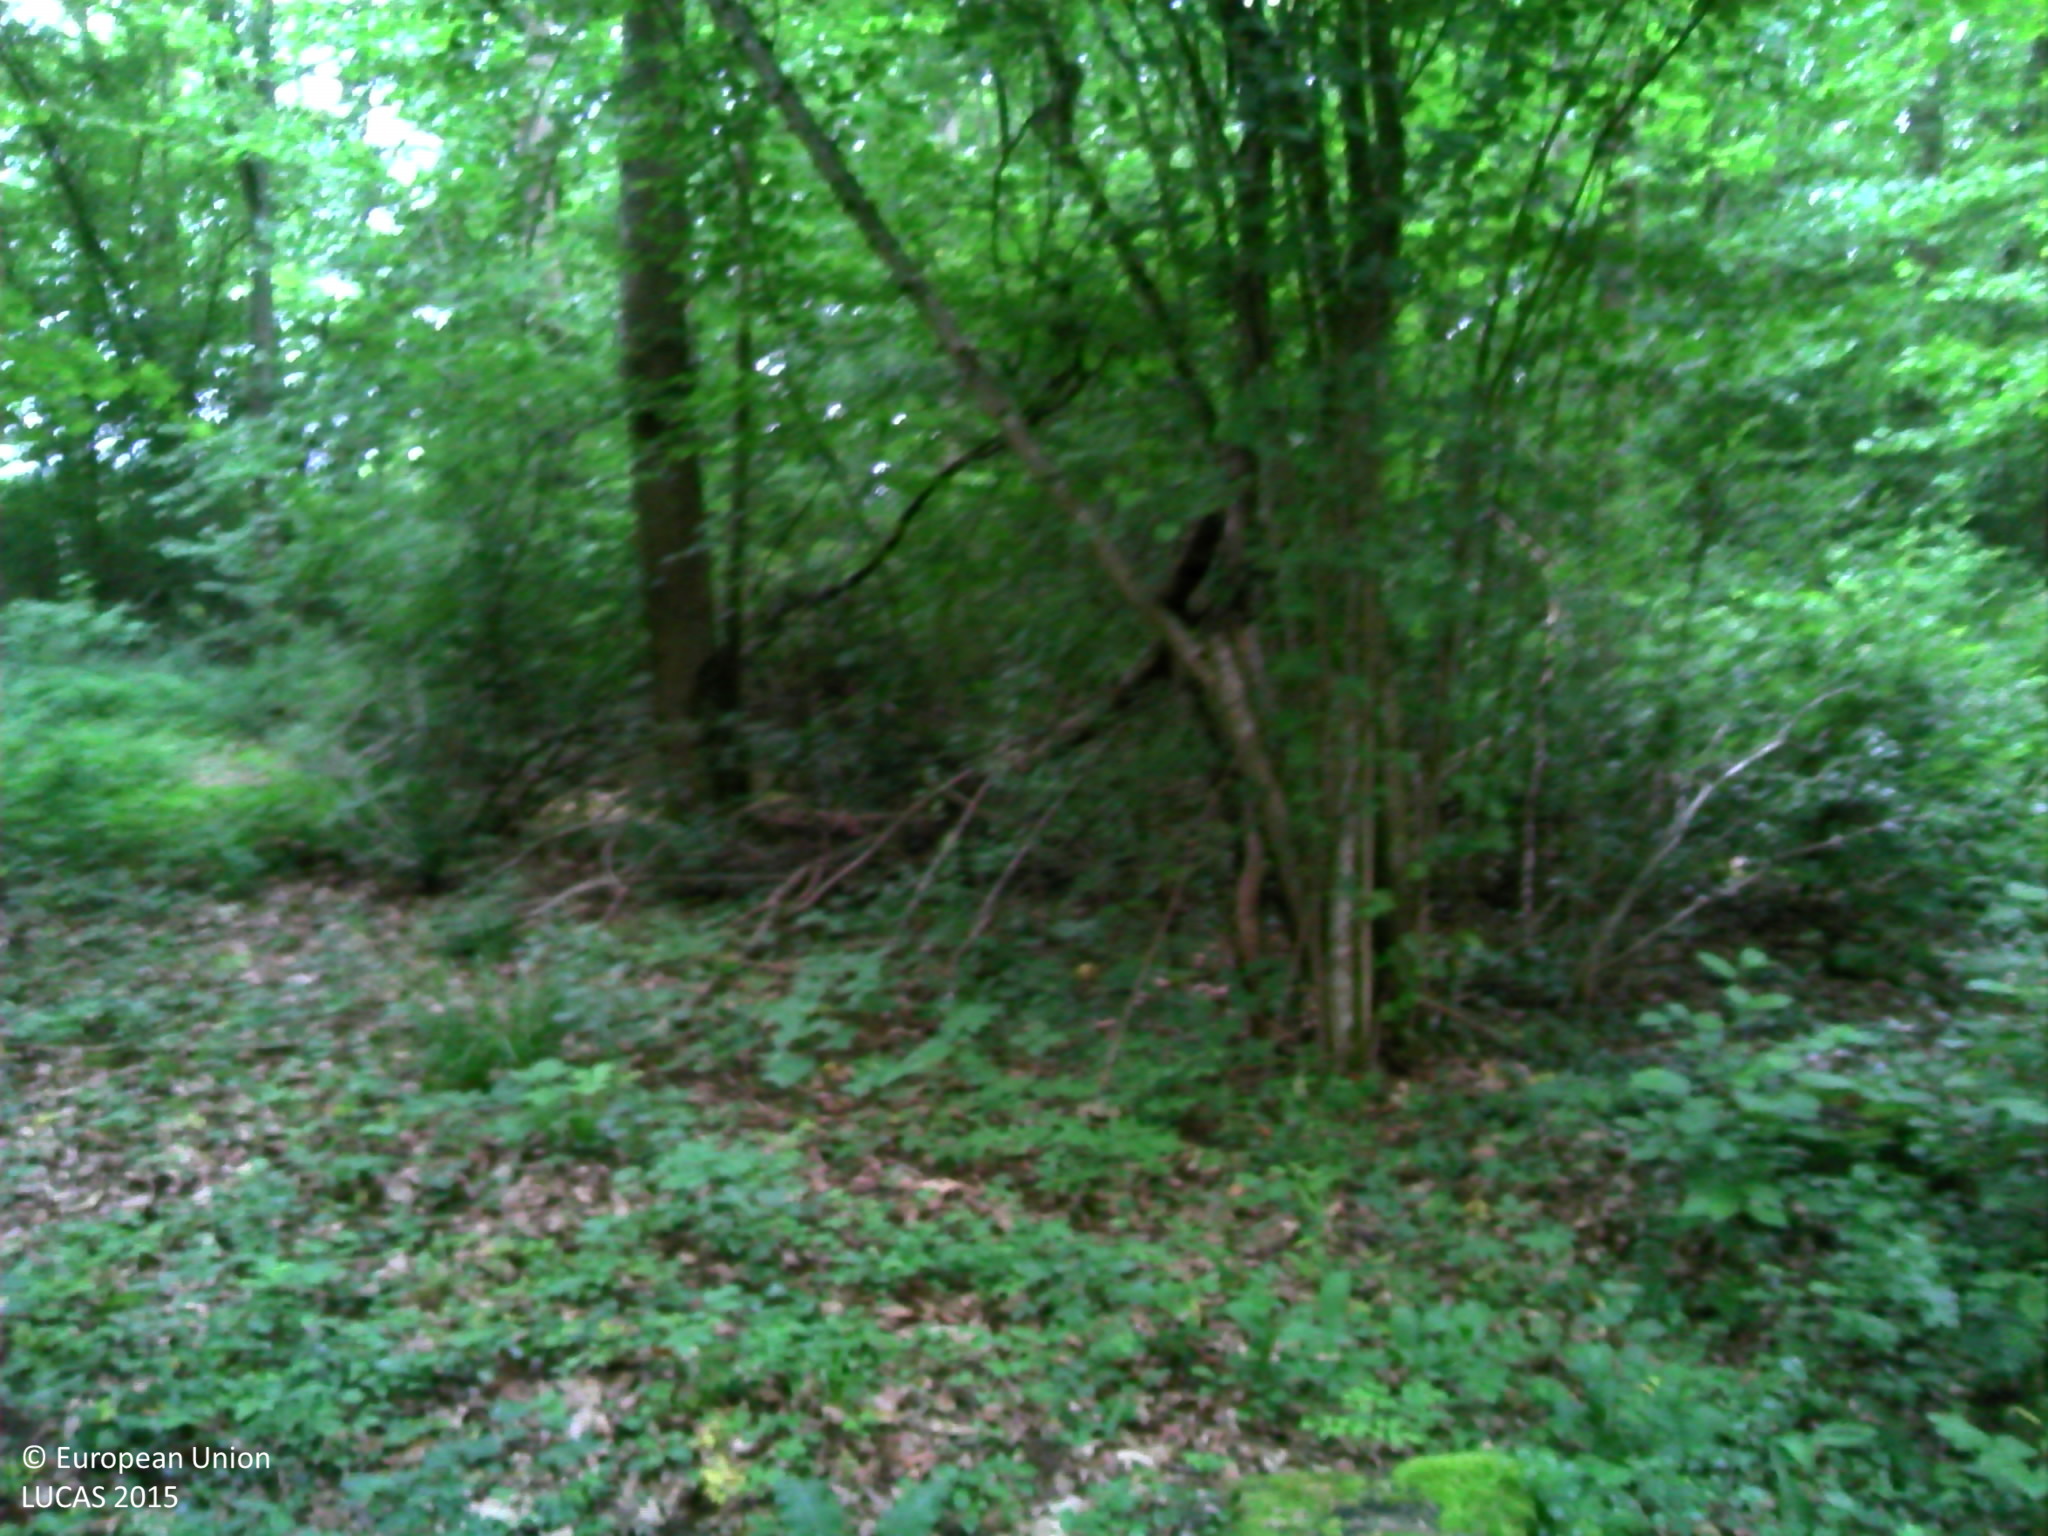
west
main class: Woodland
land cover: Broadleaved woodland
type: mesophytic deciduous forest
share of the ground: > 75 %
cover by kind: broadleaved forest trees 90 %, herbaceous plants 5 %, lichens and mosses 5 %
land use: Forestry
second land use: Amenities, museums, leisure
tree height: > 5 m
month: June
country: FR
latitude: 48.5937
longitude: 6.2987
